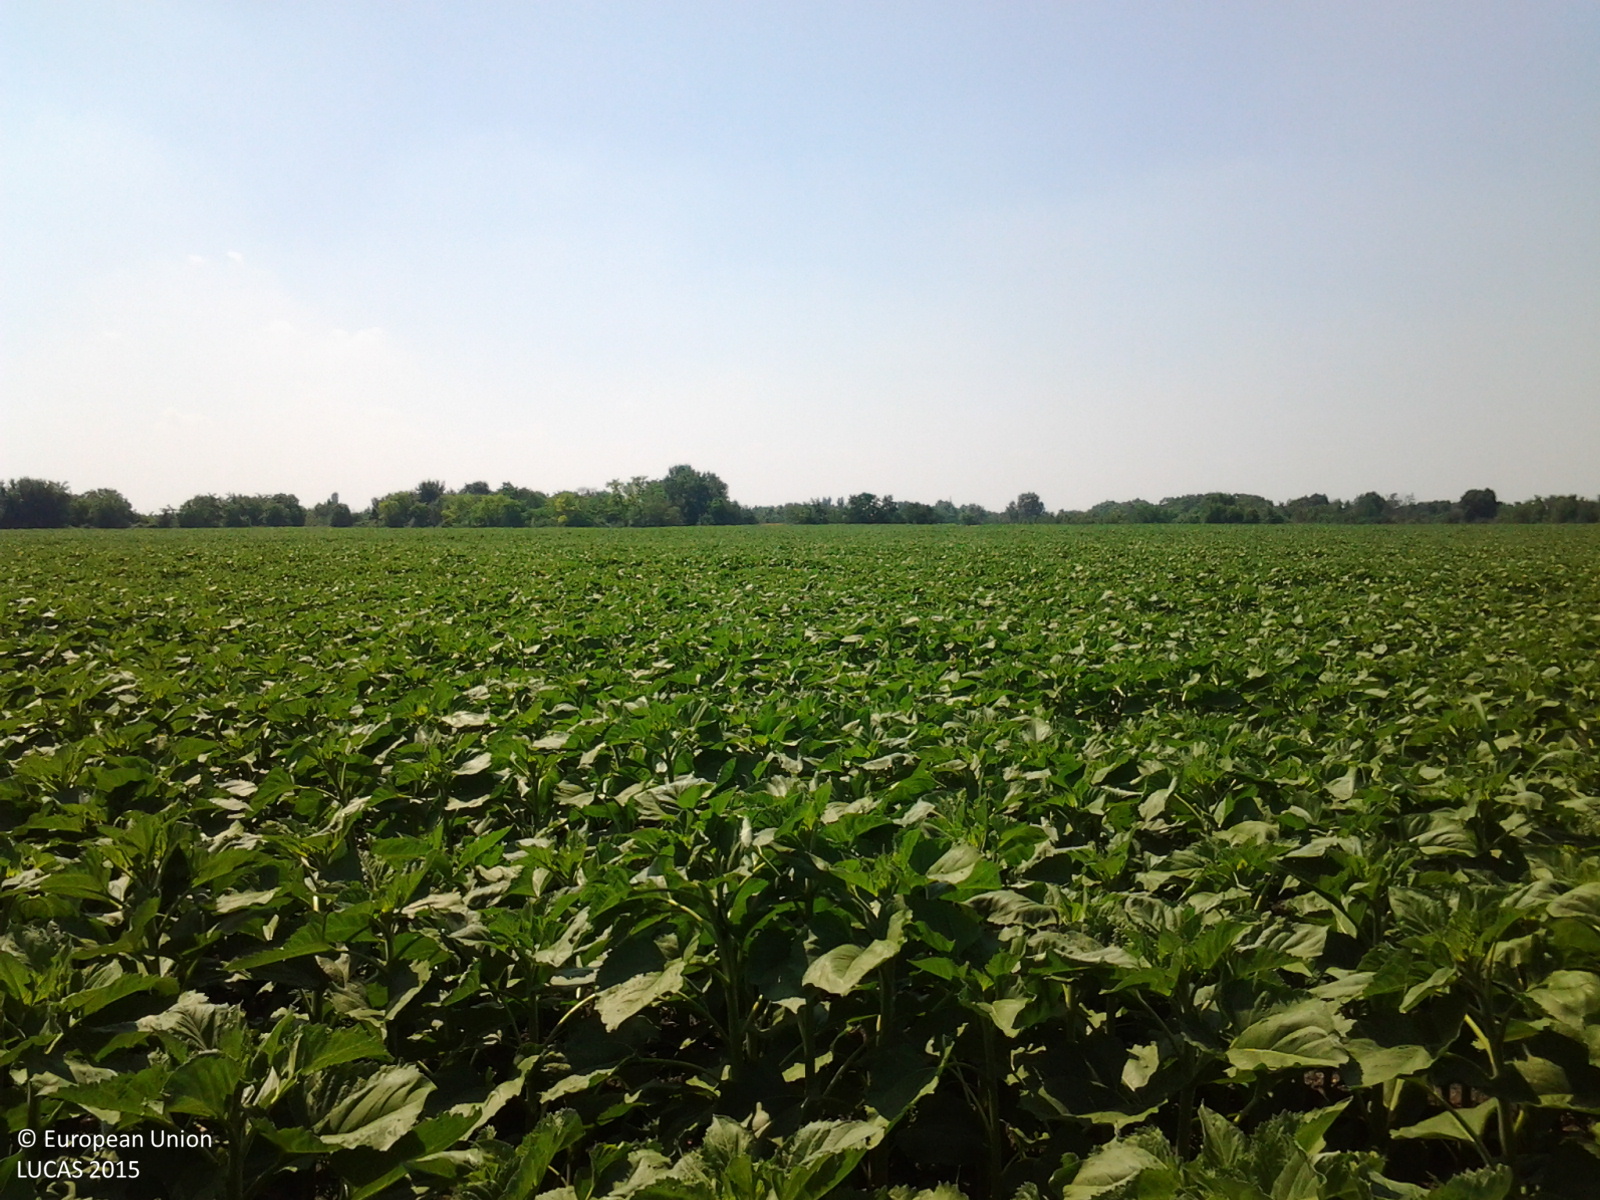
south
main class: Cropland
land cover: Sunflower
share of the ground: > 75 %
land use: Agriculture (excluding fallow land and kitchen gardens)
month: June
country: HU
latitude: 46.6581
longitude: 19.0183
